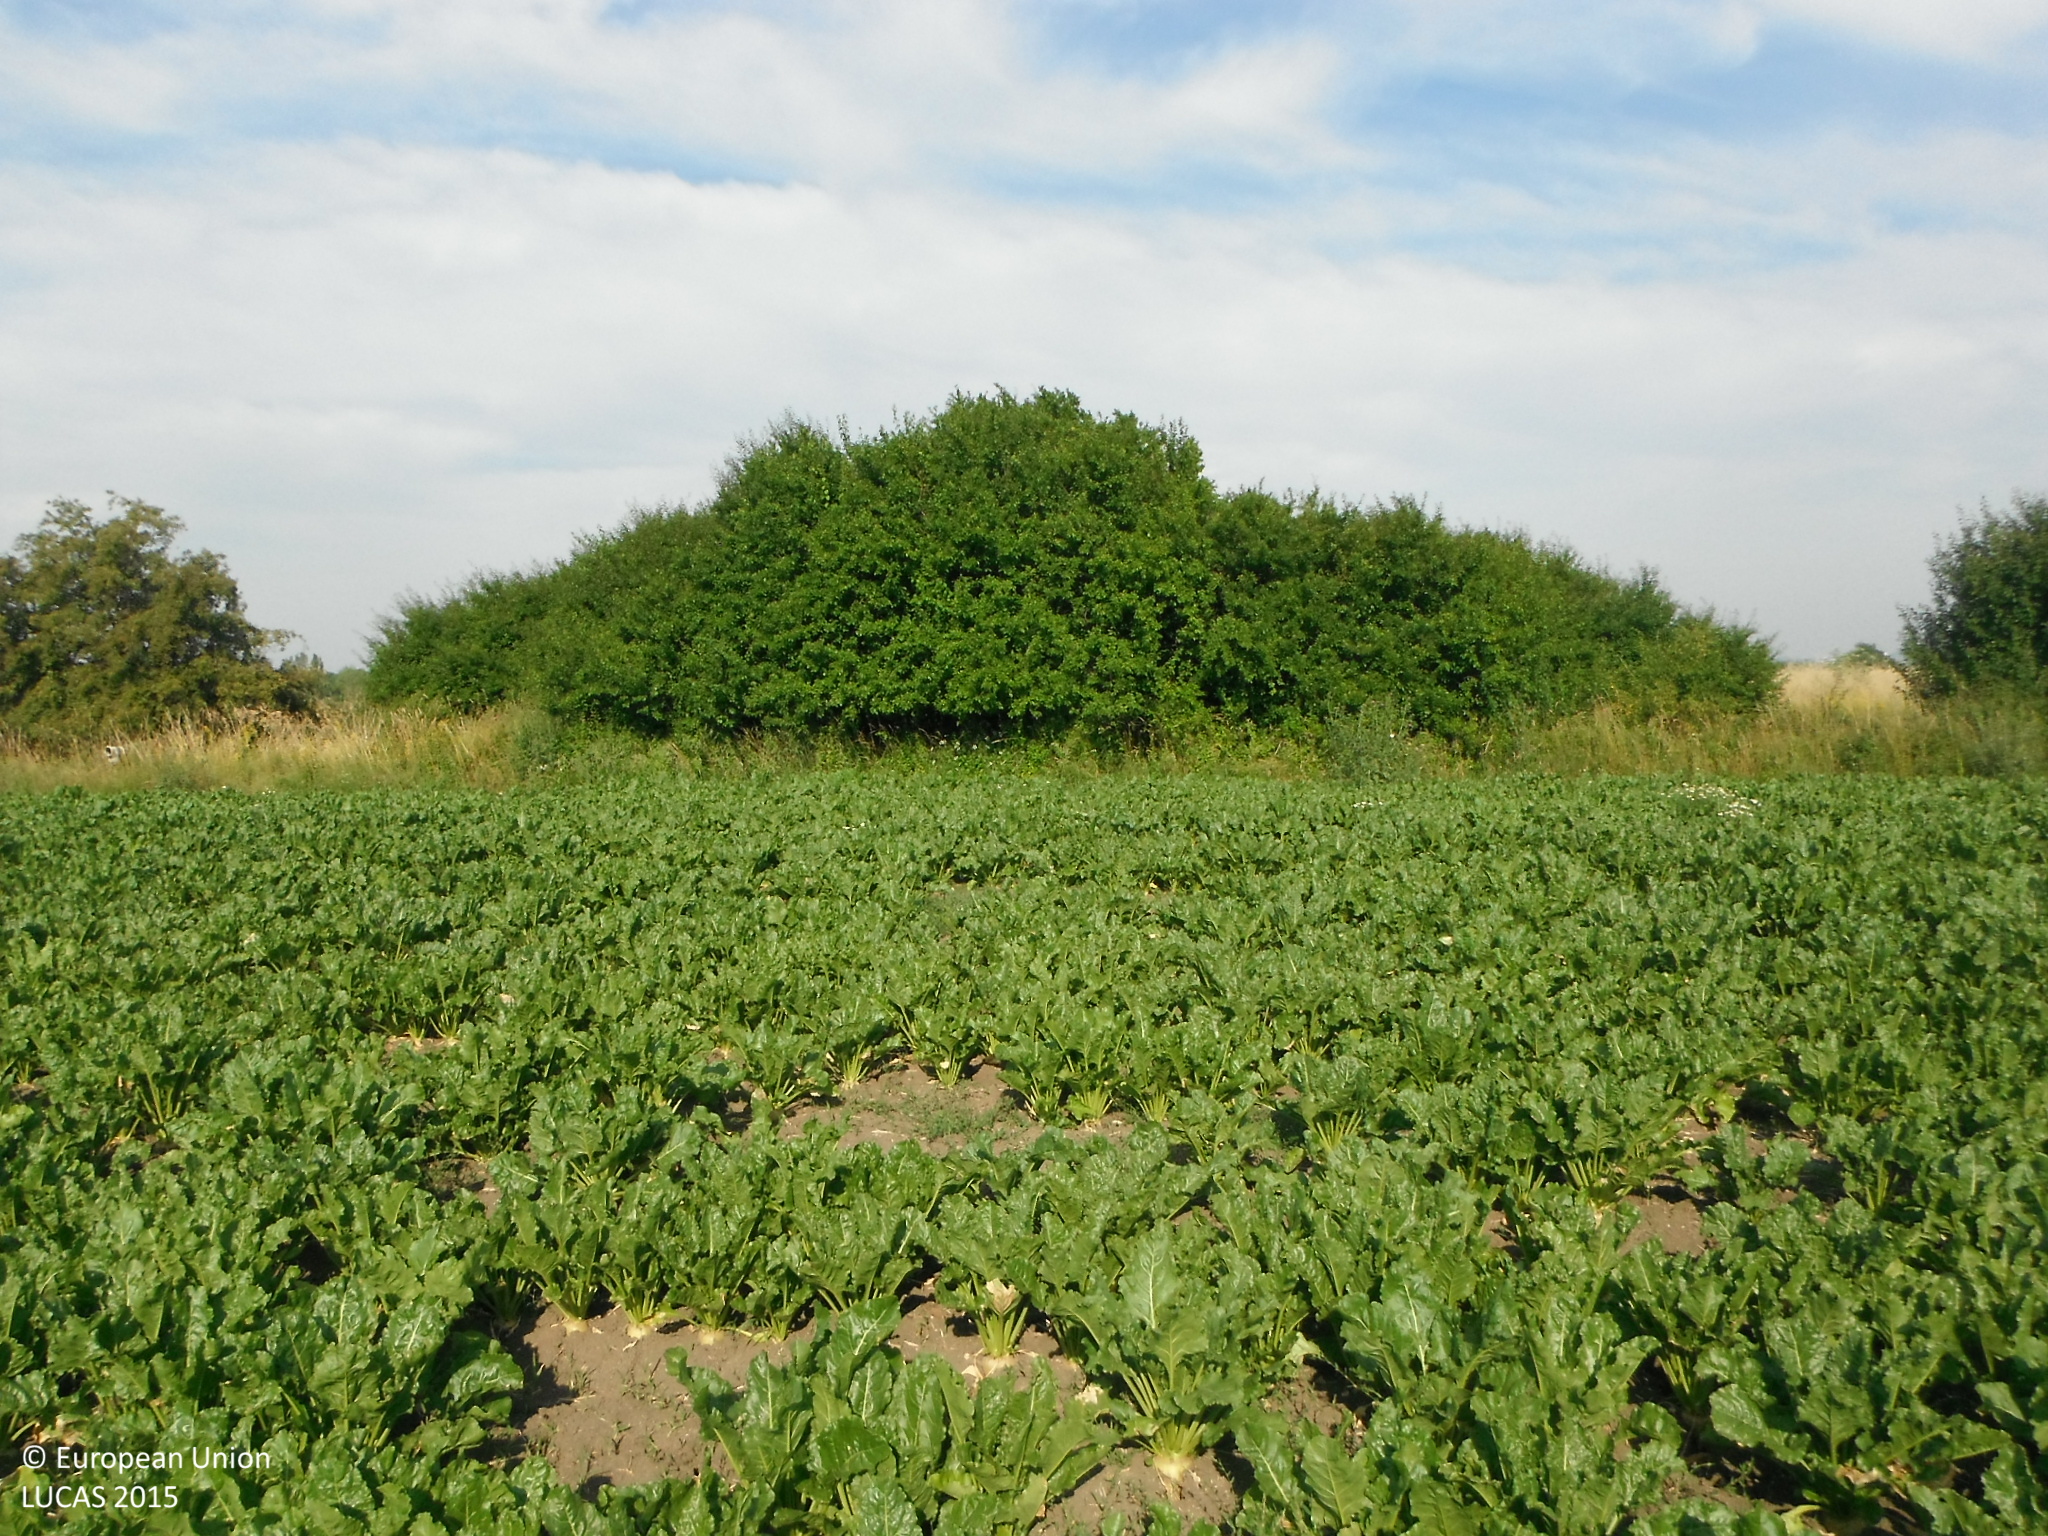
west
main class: Cropland
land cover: Sugar beet
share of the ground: > 75 %
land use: Agriculture (excluding fallow land and kitchen gardens)
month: June
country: SK
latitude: 48.4220
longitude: 17.7277
